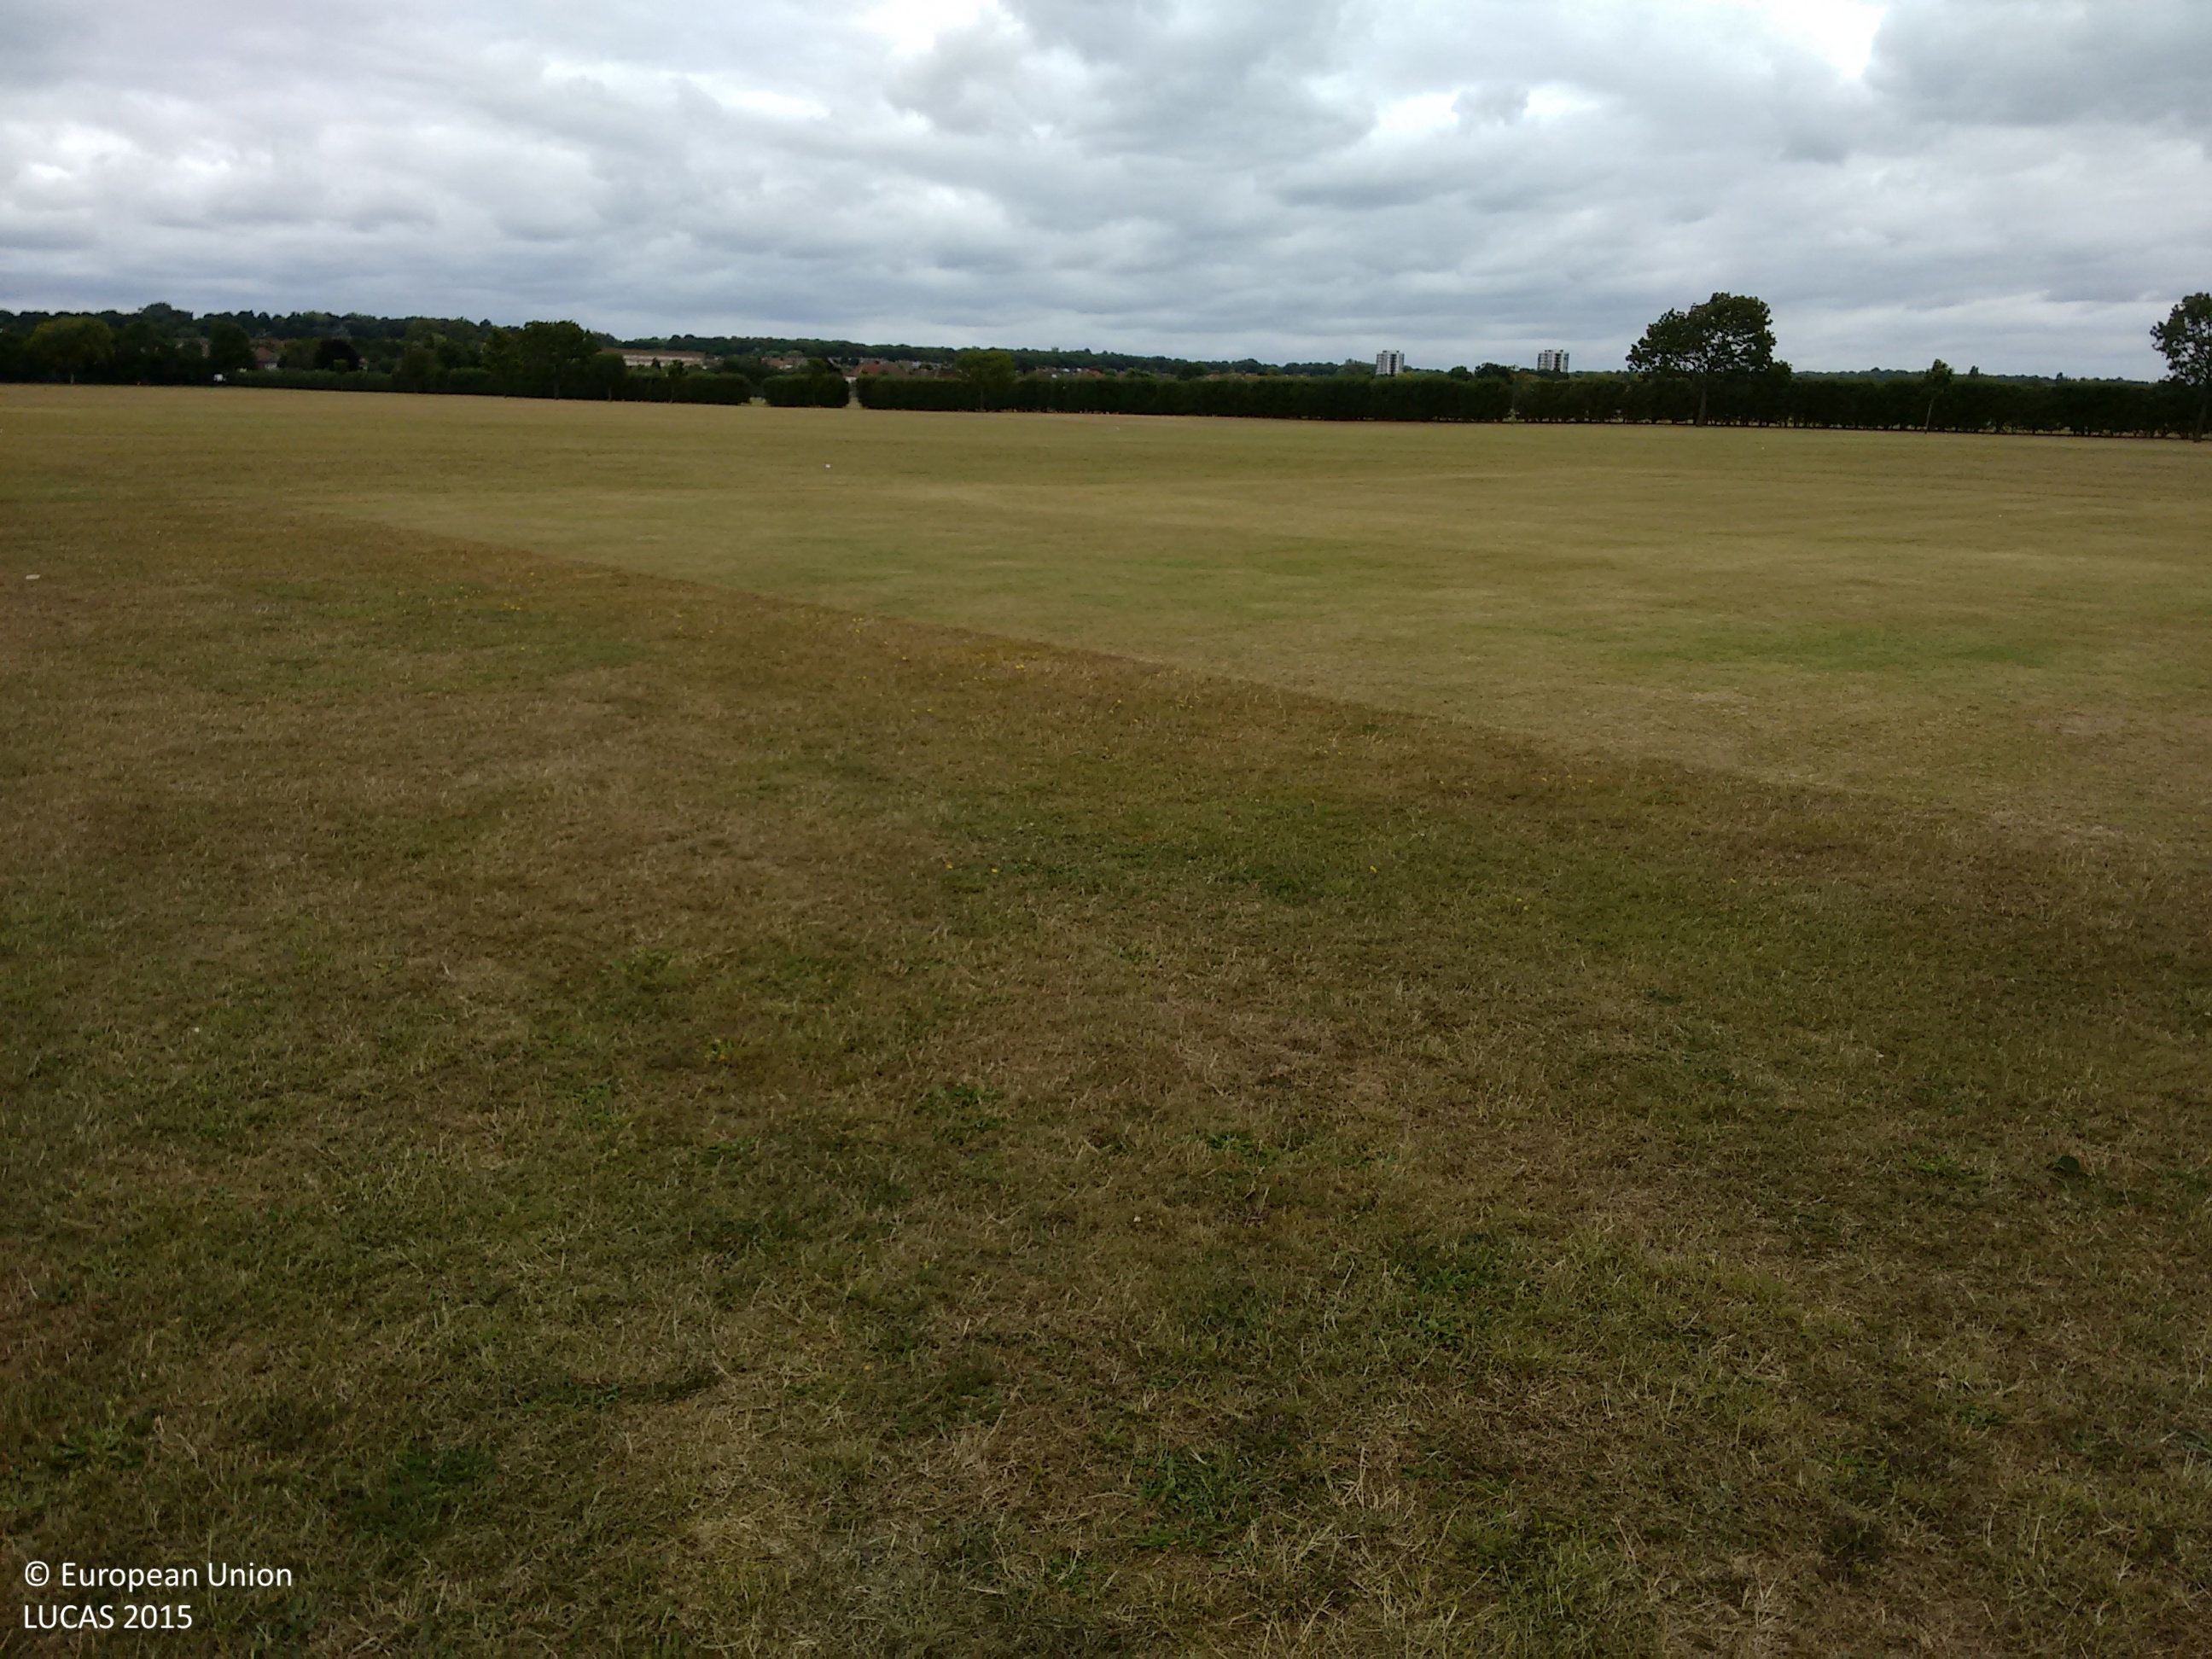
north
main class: Grassland
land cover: Grassland without tree/shrub cover
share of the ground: > 75 %
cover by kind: herbaceous plants 100 %
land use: Sport
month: July
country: GB
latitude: 51.6010
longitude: 0.1075
